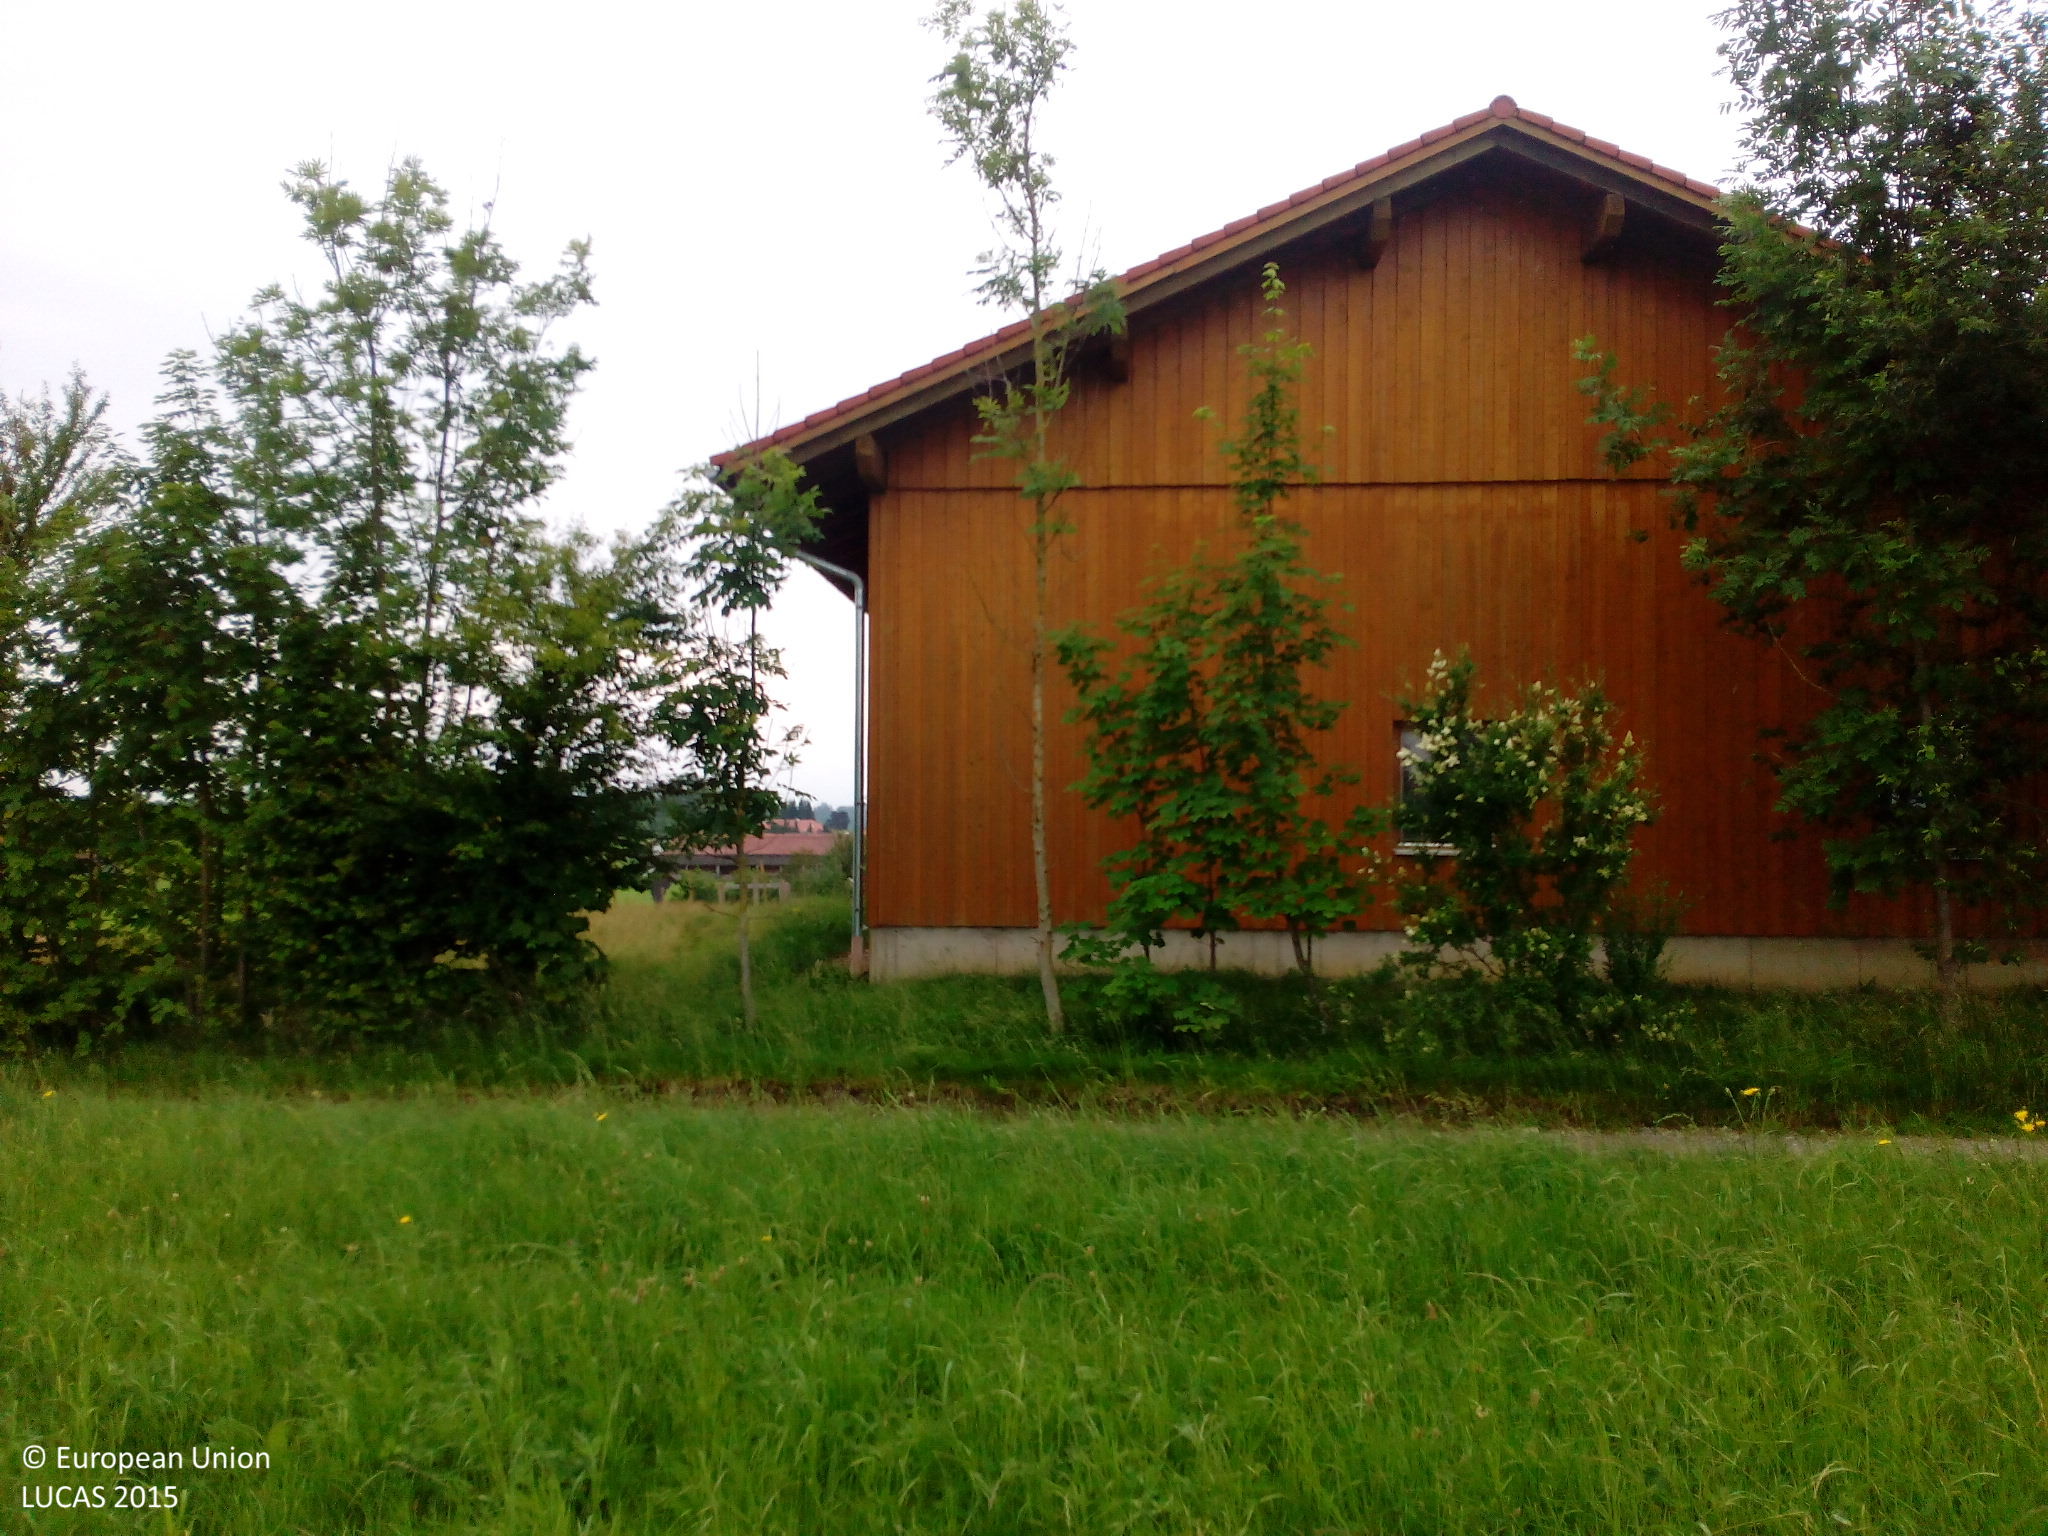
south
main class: Grassland
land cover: Grassland without tree/shrub cover
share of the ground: > 75 %
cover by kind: herbaceous plants 100 %
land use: Agriculture (excluding fallow land and kitchen gardens)
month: June
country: DE
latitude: 47.9090
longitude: 11.3771
